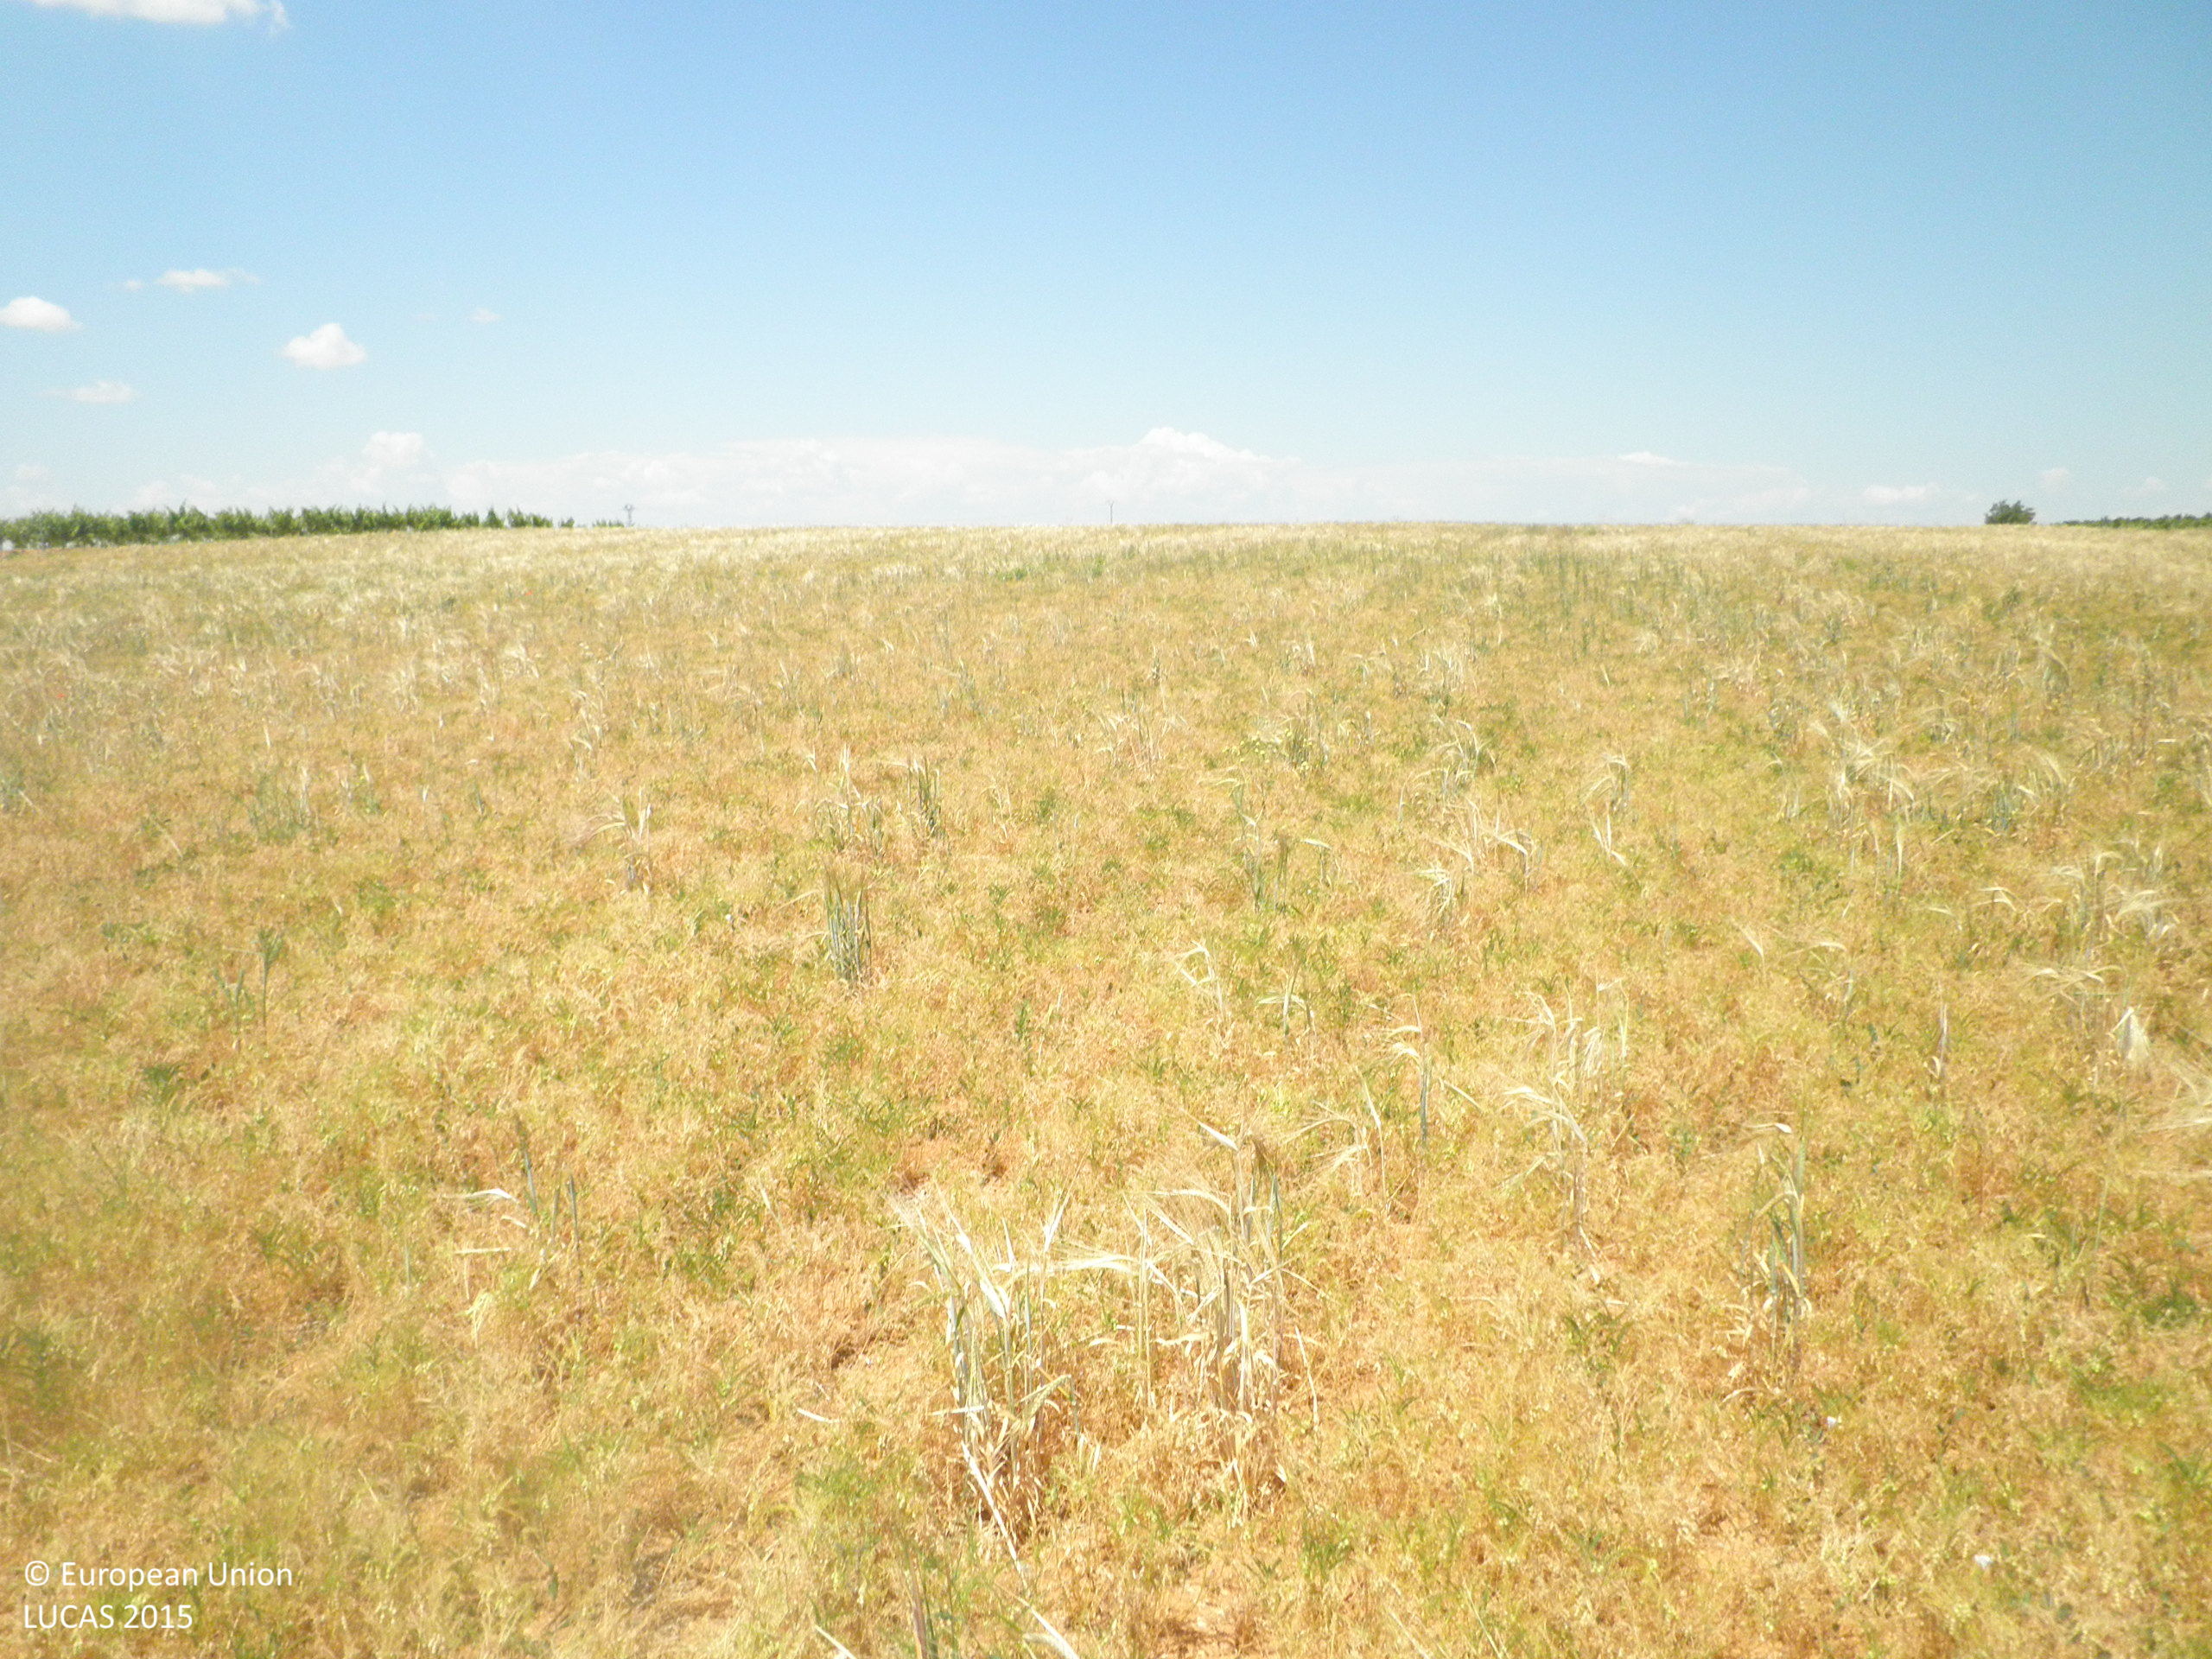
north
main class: Cropland
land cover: Dry pulses
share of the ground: 50 - 75 %
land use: Agriculture (excluding fallow land and kitchen gardens)
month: June
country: ES
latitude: 39.3207
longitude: -1.7537
